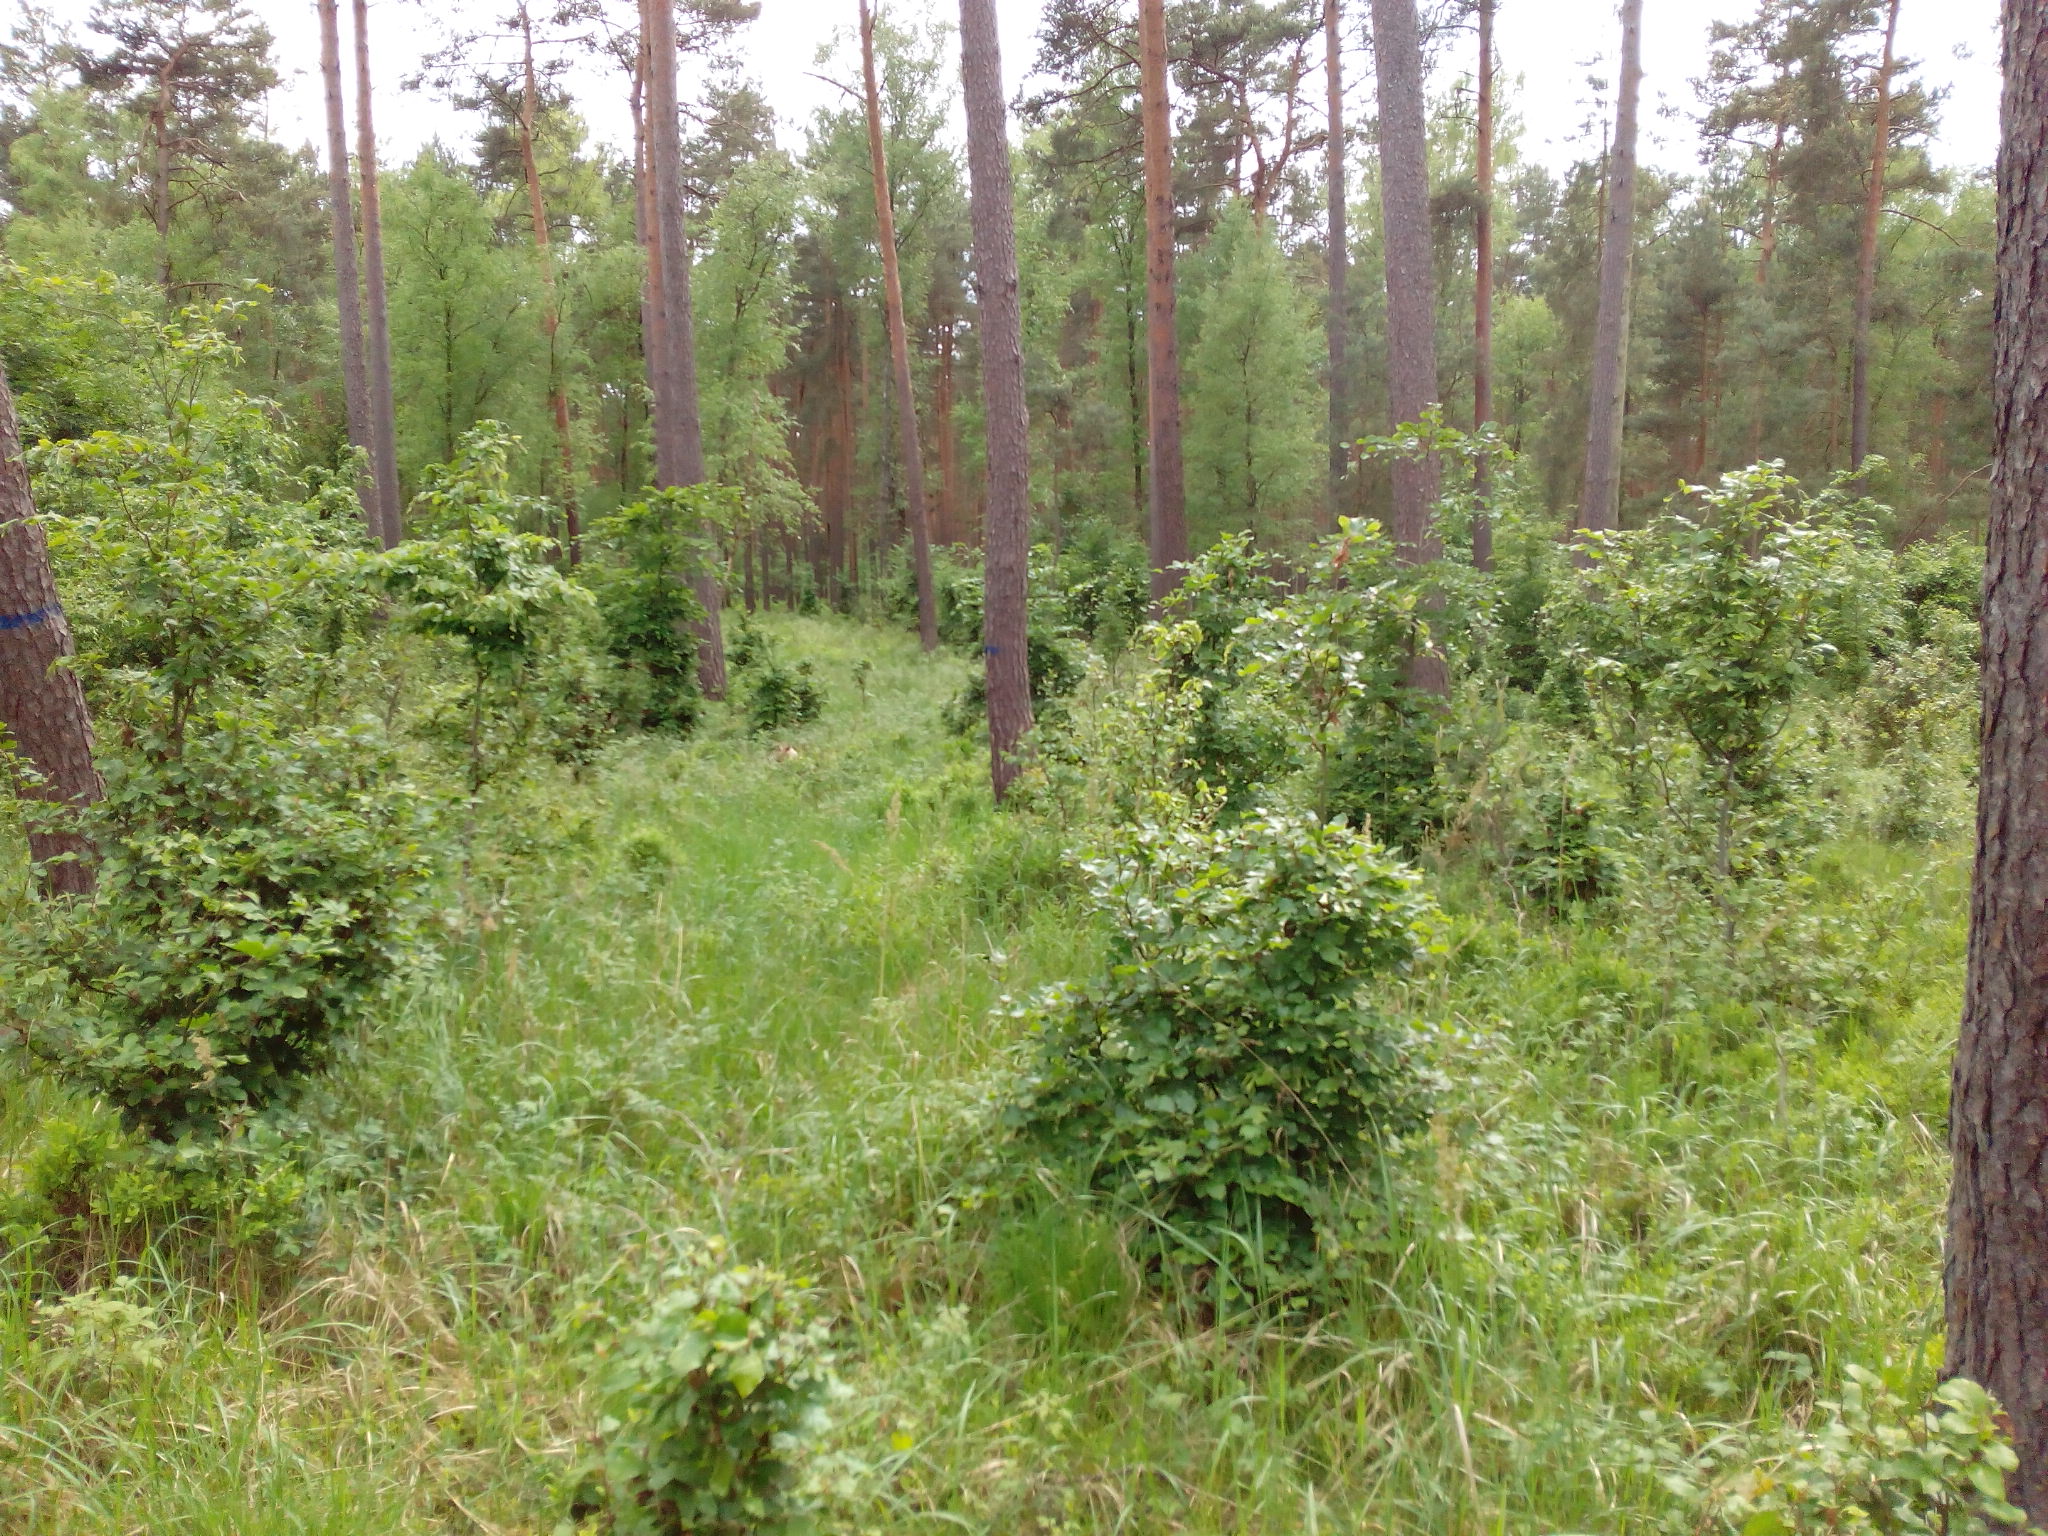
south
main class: Woodland
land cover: Pine dominated mixed woodland
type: hemiboreal forest and nemoral coniferous forest and mixed broadleaved-coniferous forest
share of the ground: > 75 %
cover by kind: coniferous forest trees 50 %, broadleaved forest trees 20 %, shrubs 20 %, herbaceous plants 10 %
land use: Forestry
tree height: > 5 m
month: June
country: DE
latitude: 52.6111
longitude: 9.9262
